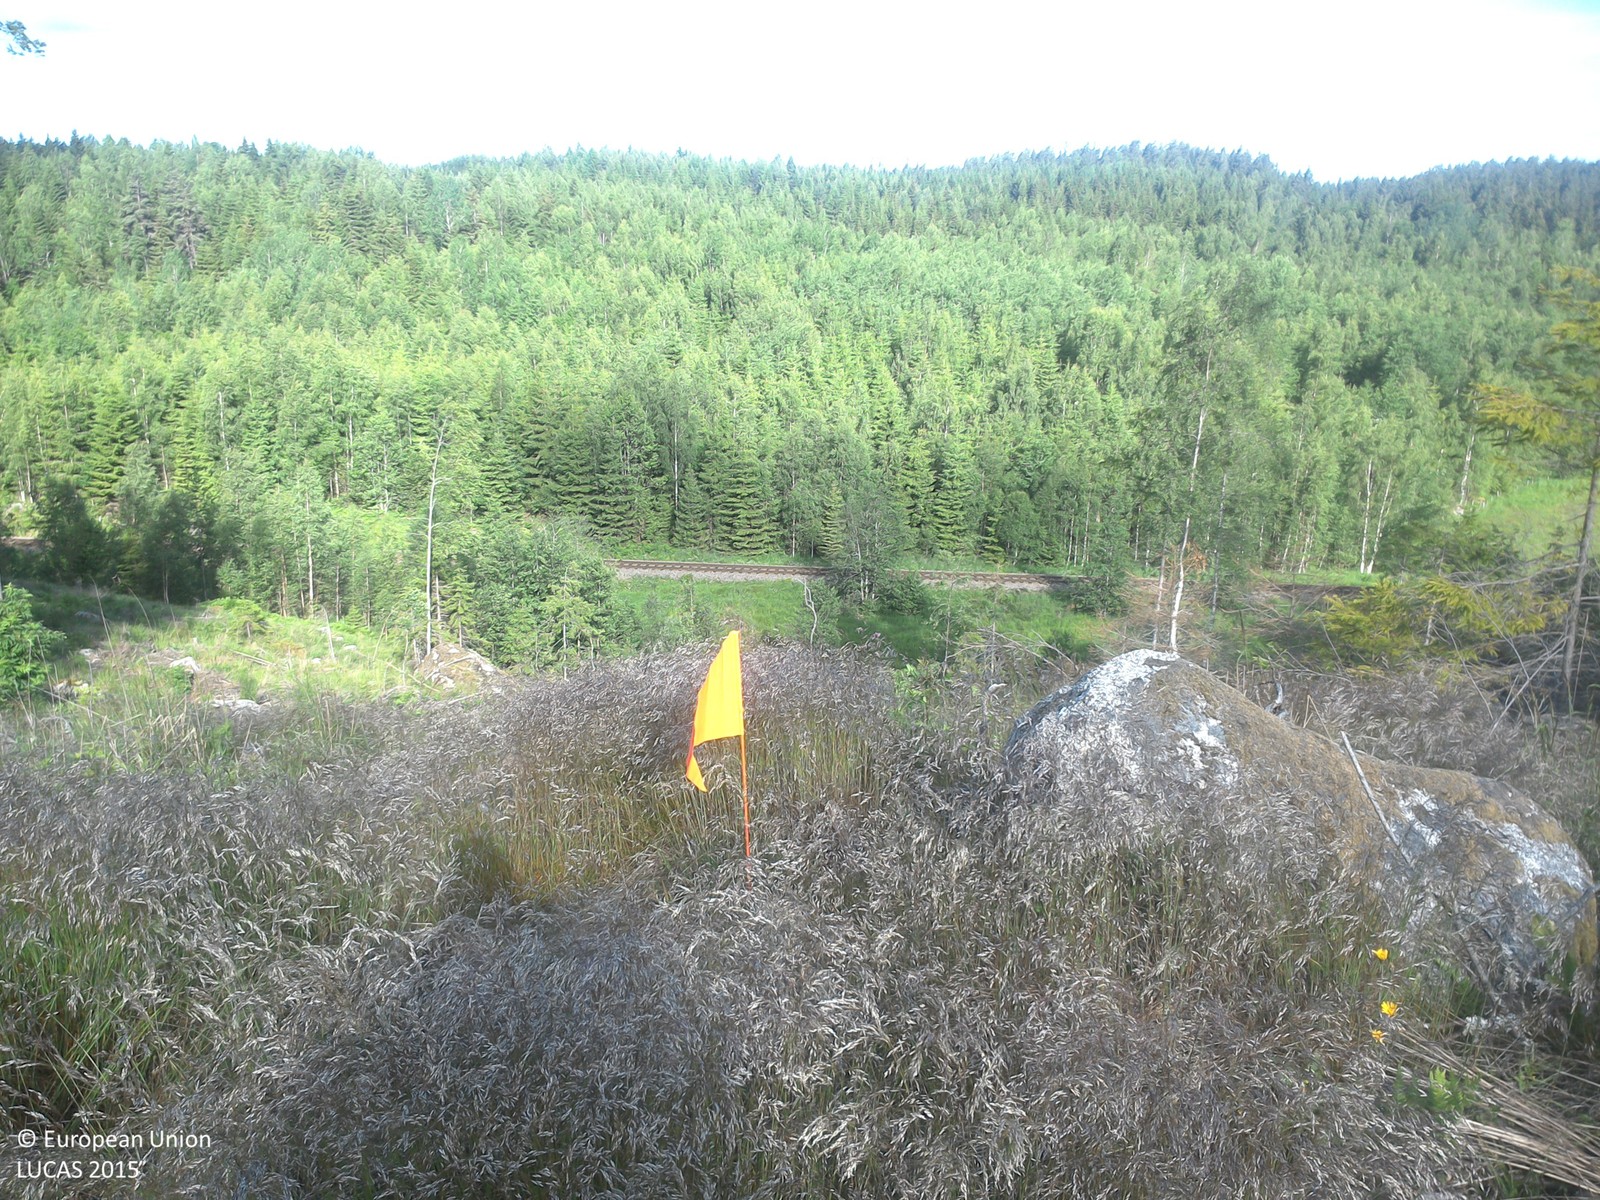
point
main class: Grassland
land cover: Grassland with sparse tree/shrub cover
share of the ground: > 75 %
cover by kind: herbaceous plants 90 %, coniferous forest trees 5 %, shrubs 5 %
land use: Forestry
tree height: < 5 m
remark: Clear cut
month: June
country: SE
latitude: 58.1010
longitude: 15.6455
